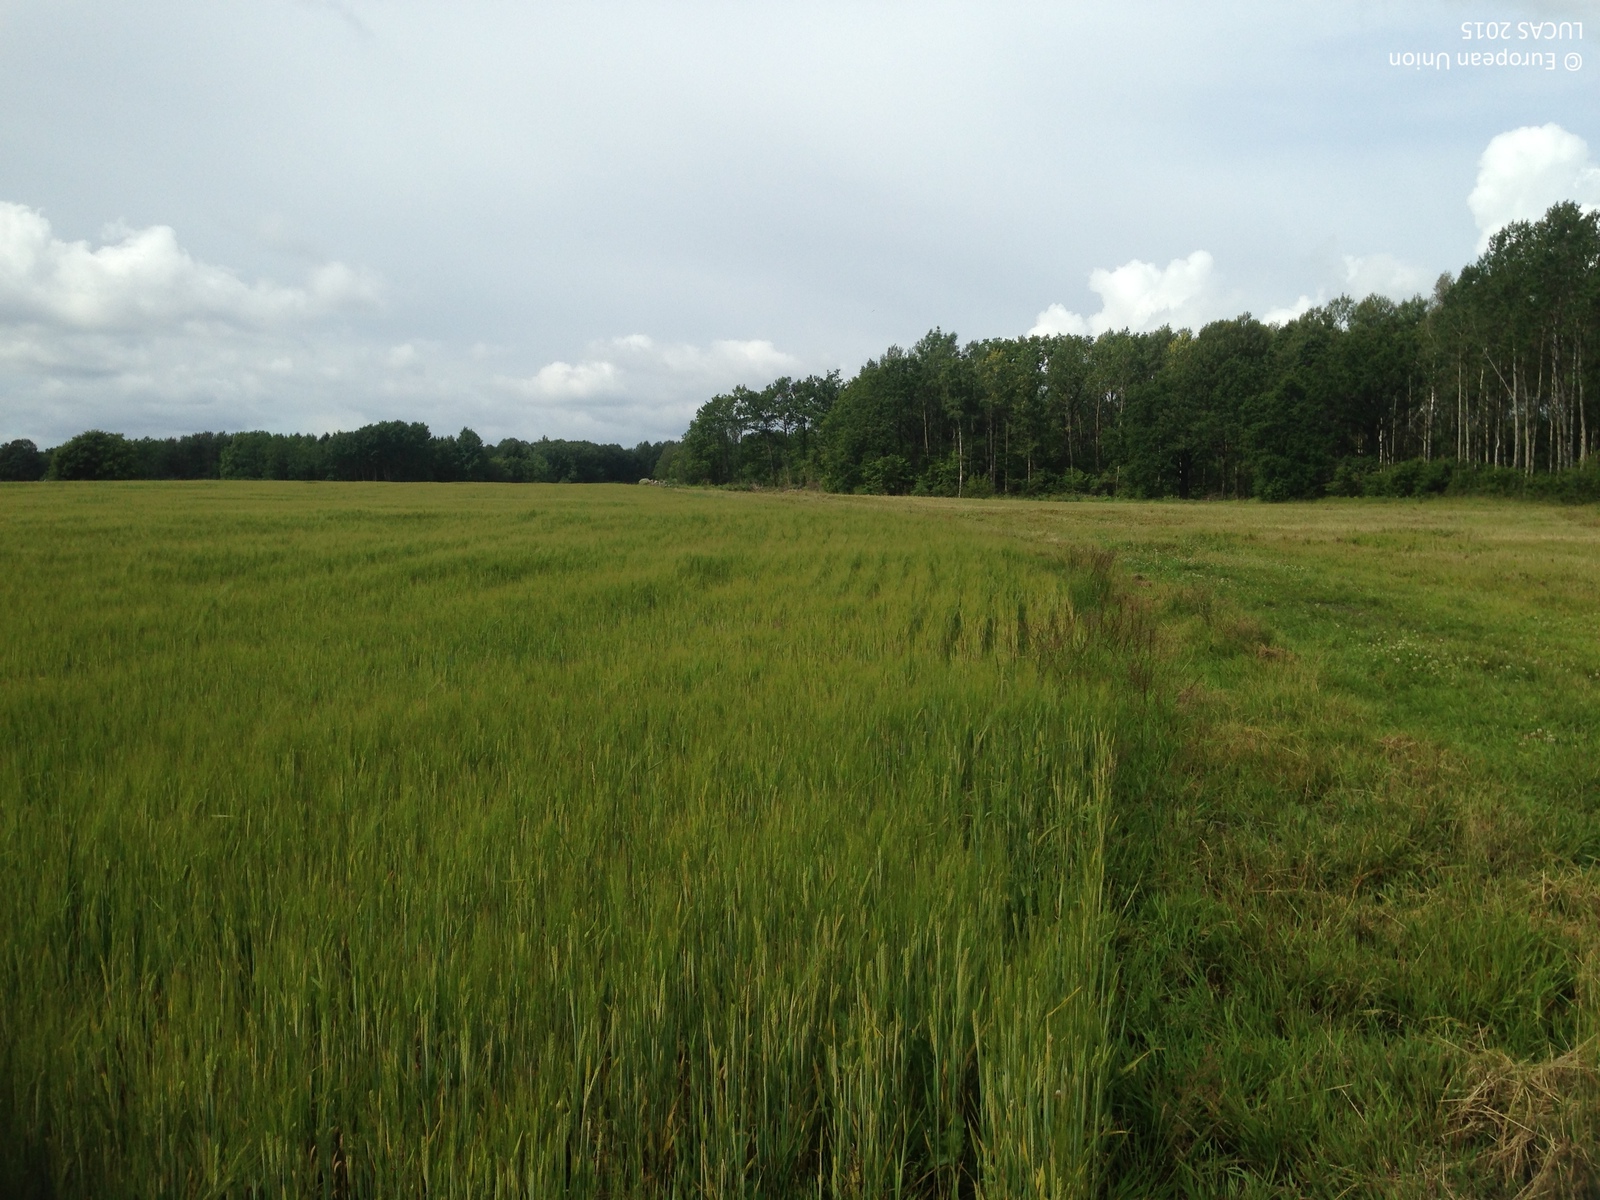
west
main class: Cropland
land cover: Barley
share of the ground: > 75 %
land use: Agriculture (excluding fallow land and kitchen gardens)
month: July
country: SE
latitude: 59.8598
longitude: 18.6588
